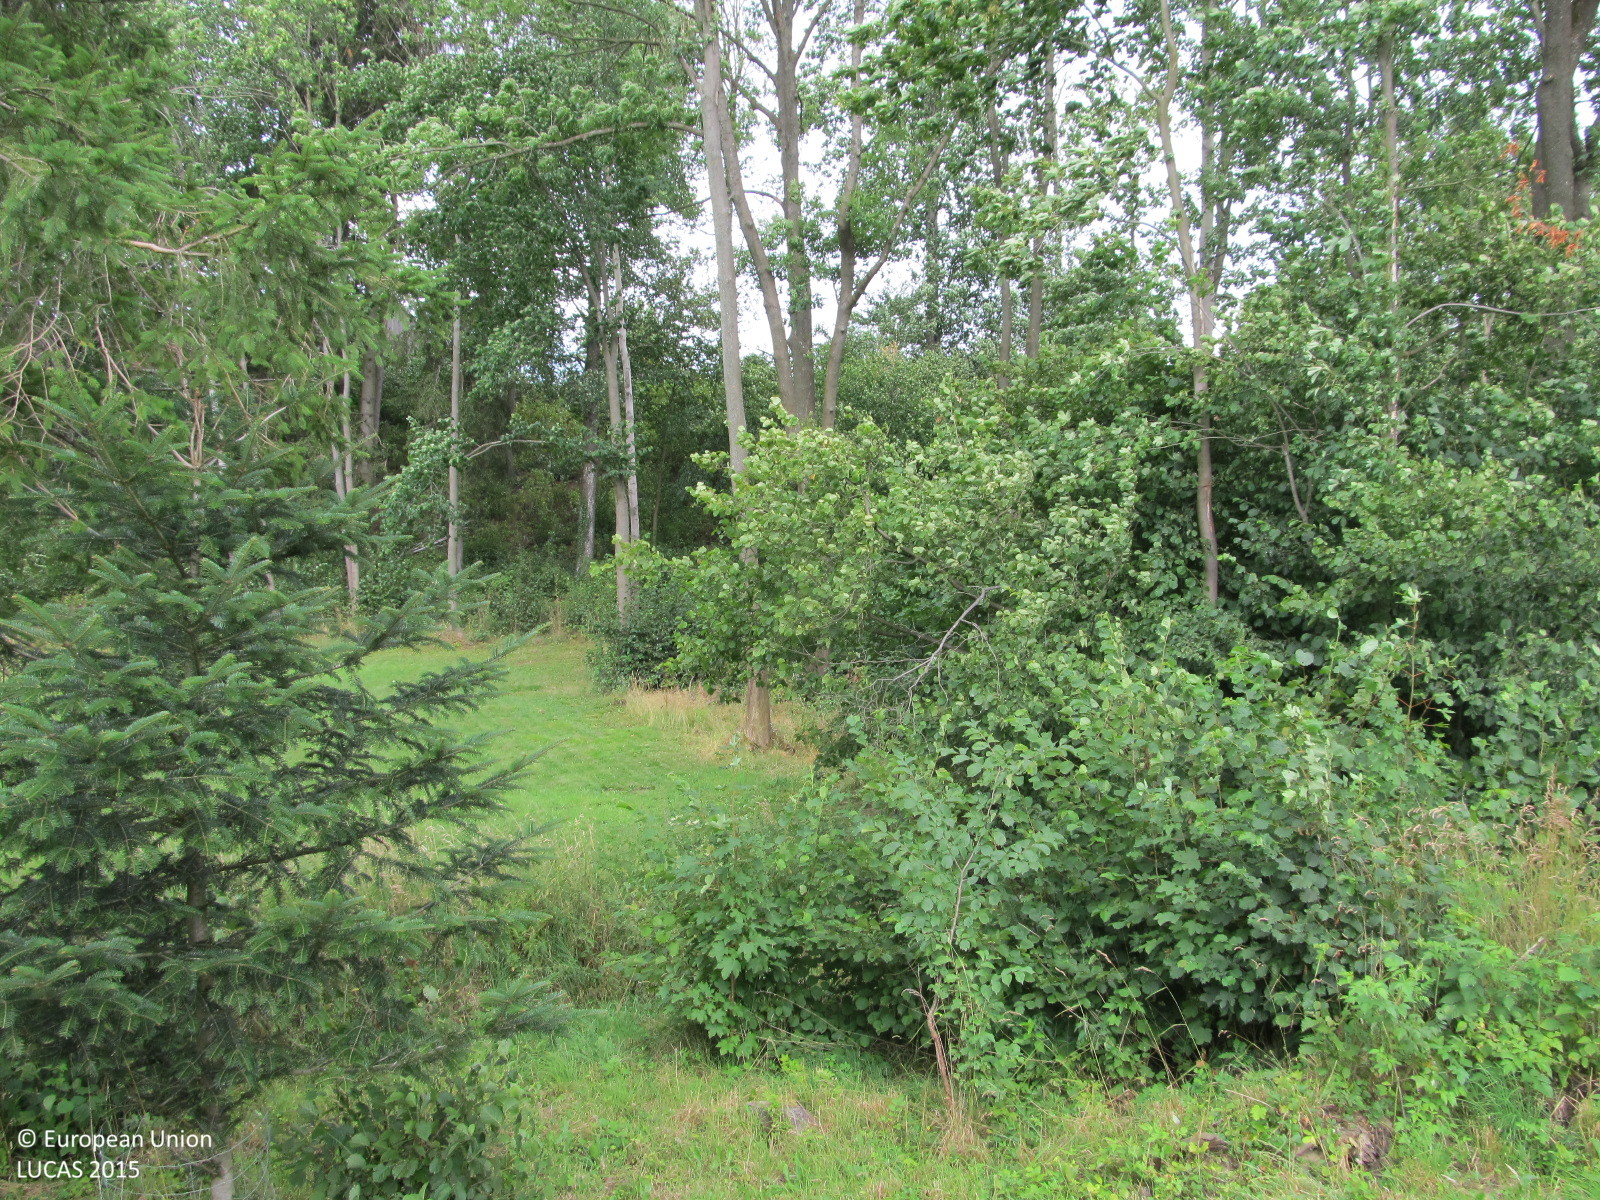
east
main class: Grassland
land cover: Grassland with sparse tree/shrub cover
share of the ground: > 75 %
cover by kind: herbaceous plants 85 %, shrubs 10 %, coniferous forest trees 5 %
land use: Agriculture (excluding fallow land and kitchen gardens)
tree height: < 5 m
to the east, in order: Grassland with sparse tree/shrub cover; Other mixed woodland; Rivers and streams; Broadleaved woodland; Grass margins; Fences; Spontaneously vegetated surfaces; Fences; Grassland without tree/shrub cover; Fences; Grassland without tree/shrub cover; Fences; Broadleaved woodland; Grass margins; Paved roads, cycling and walking lanes; Grass margins; Clovers; Common wheat; Grass margins
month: July
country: AT
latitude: 48.6647
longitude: 15.0937
